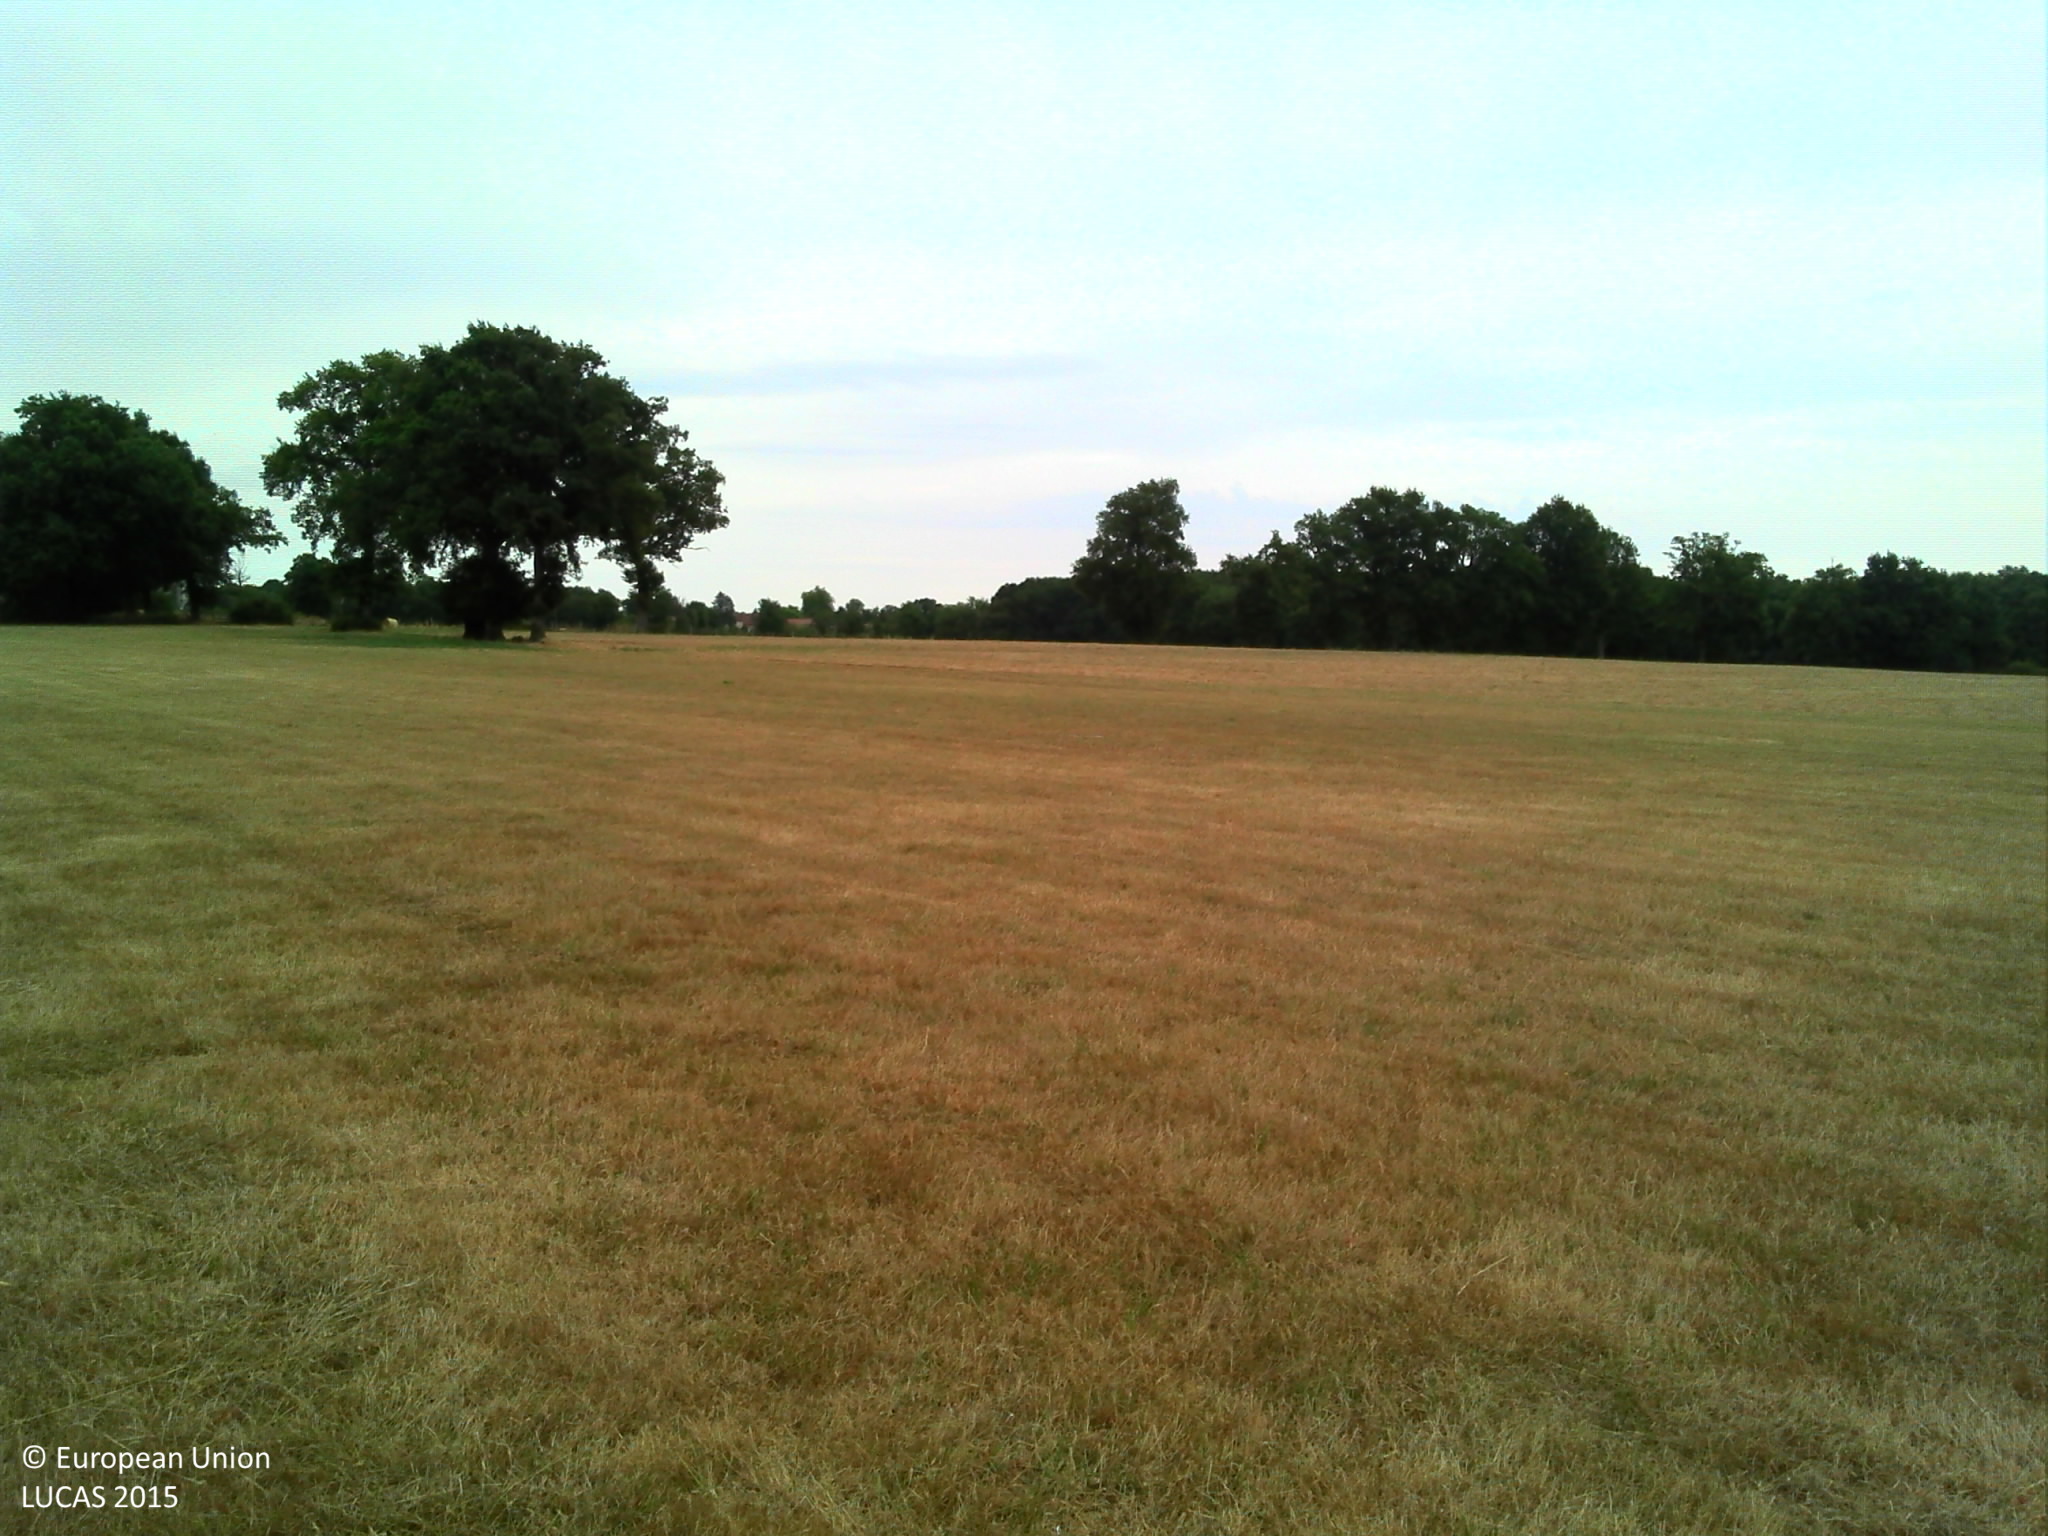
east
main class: Grassland
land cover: Grassland without tree/shrub cover
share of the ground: > 75 %
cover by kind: herbaceous plants 100 %
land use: Agriculture (excluding fallow land and kitchen gardens)
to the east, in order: Grassland without tree/shrub cover; Ditches and canals; Fences; Barley
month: July
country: FR
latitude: 46.2786
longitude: 0.9936
